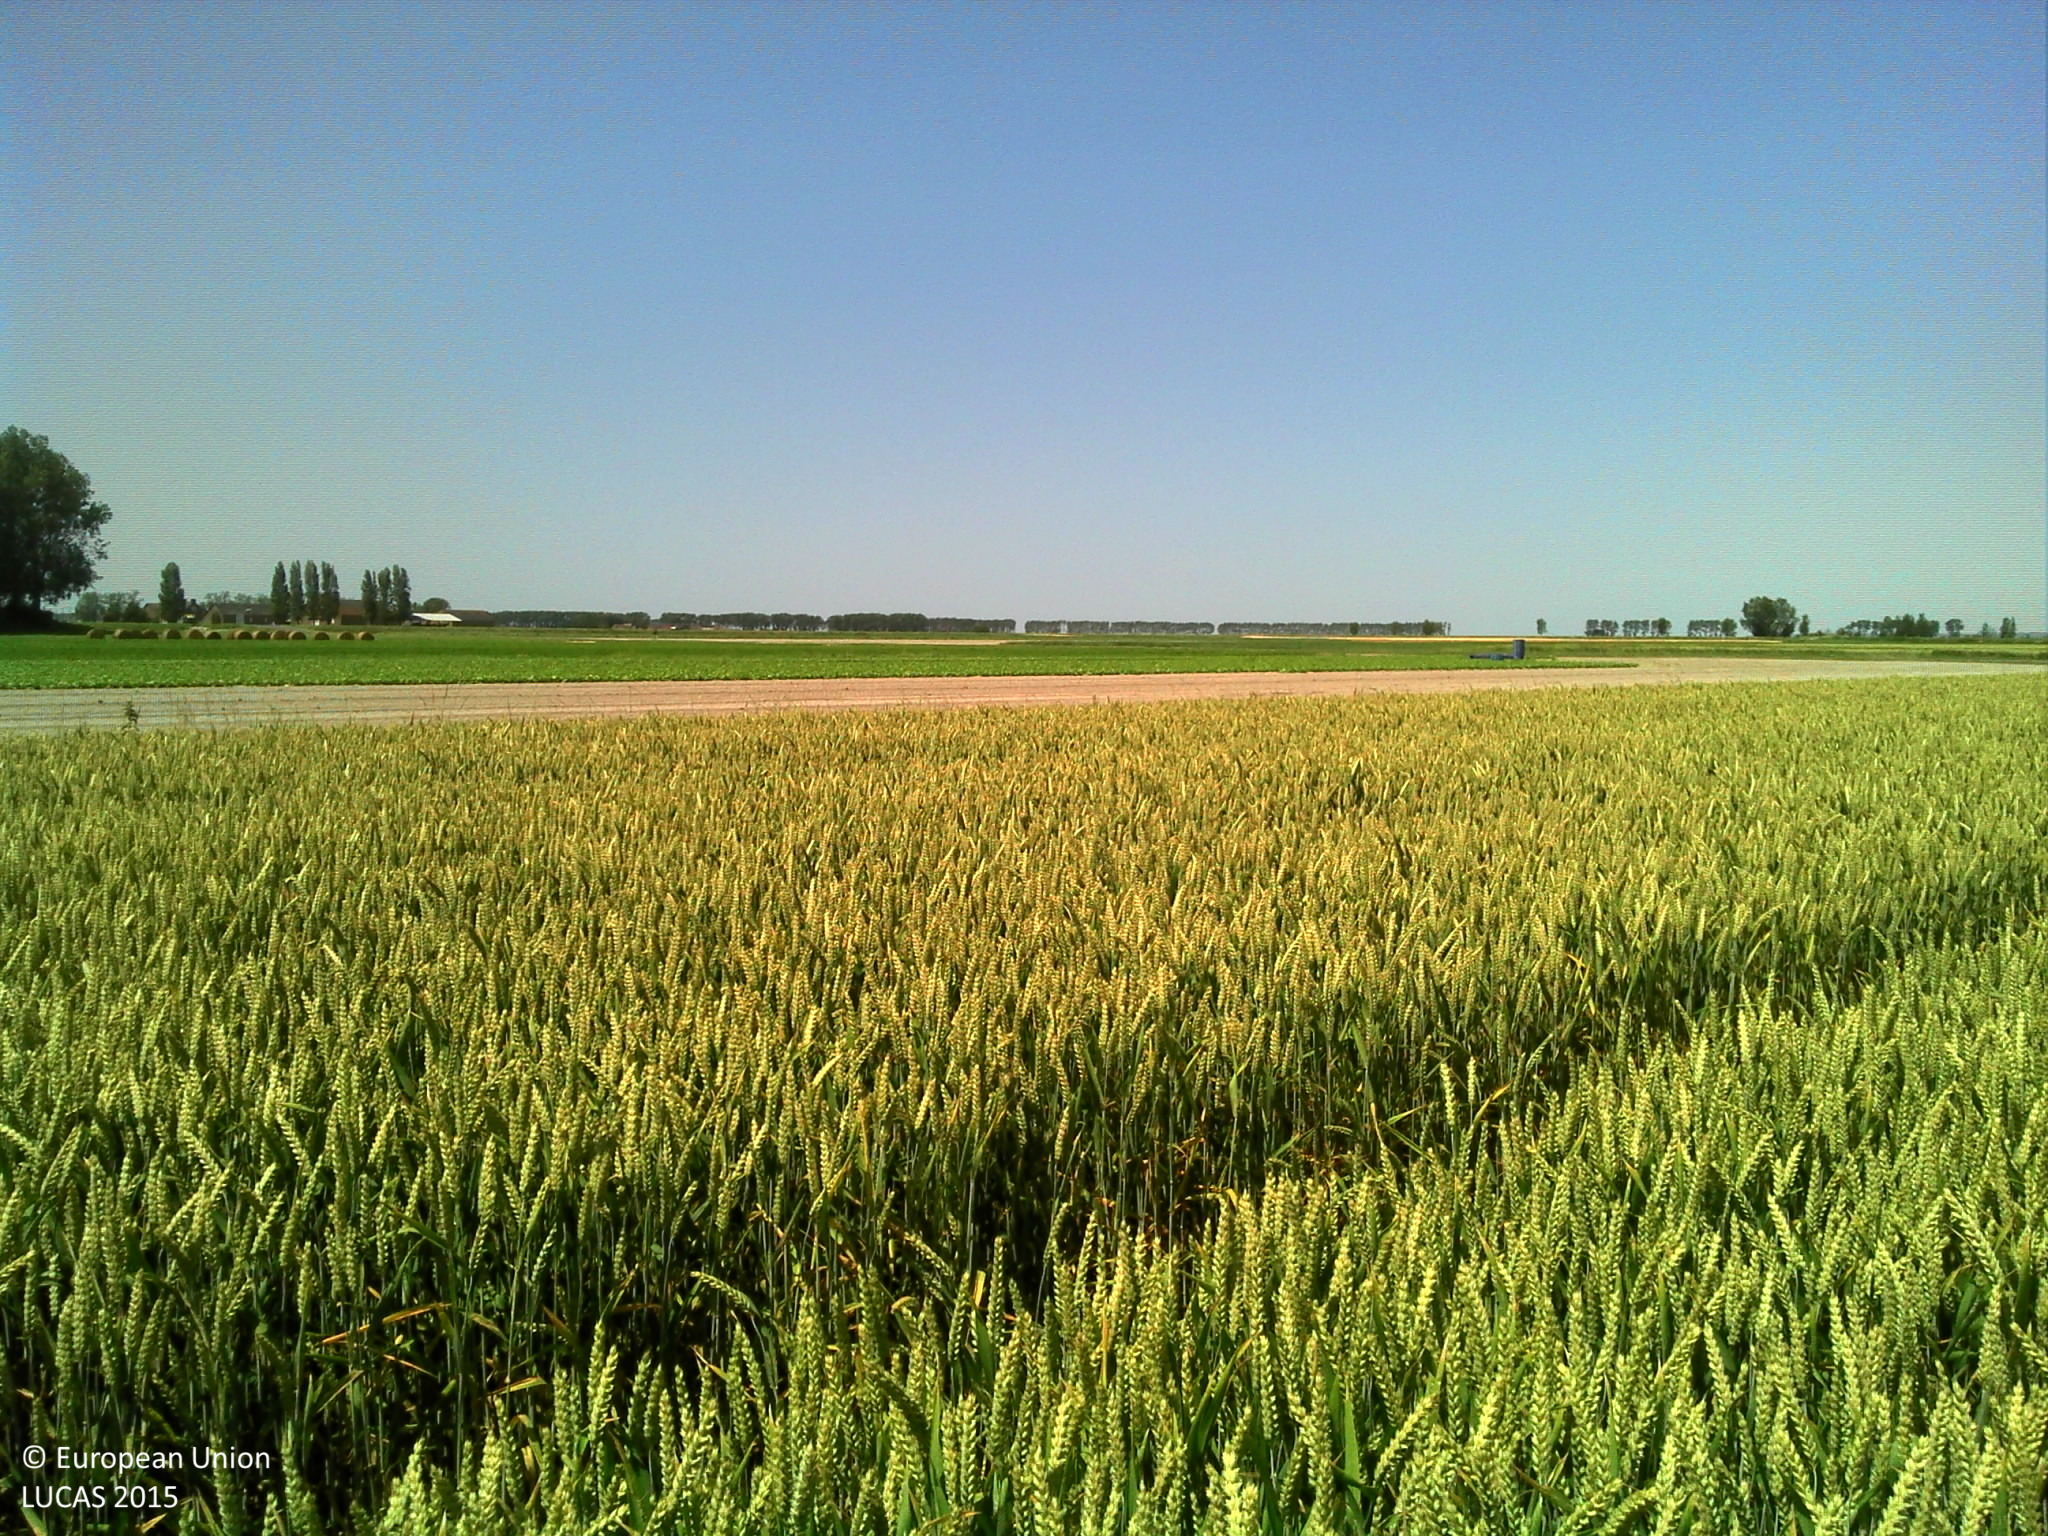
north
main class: Cropland
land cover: Common wheat
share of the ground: > 75 %
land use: Agriculture (excluding fallow land and kitchen gardens)
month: June
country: FR
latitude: 48.5946
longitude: -1.5597
